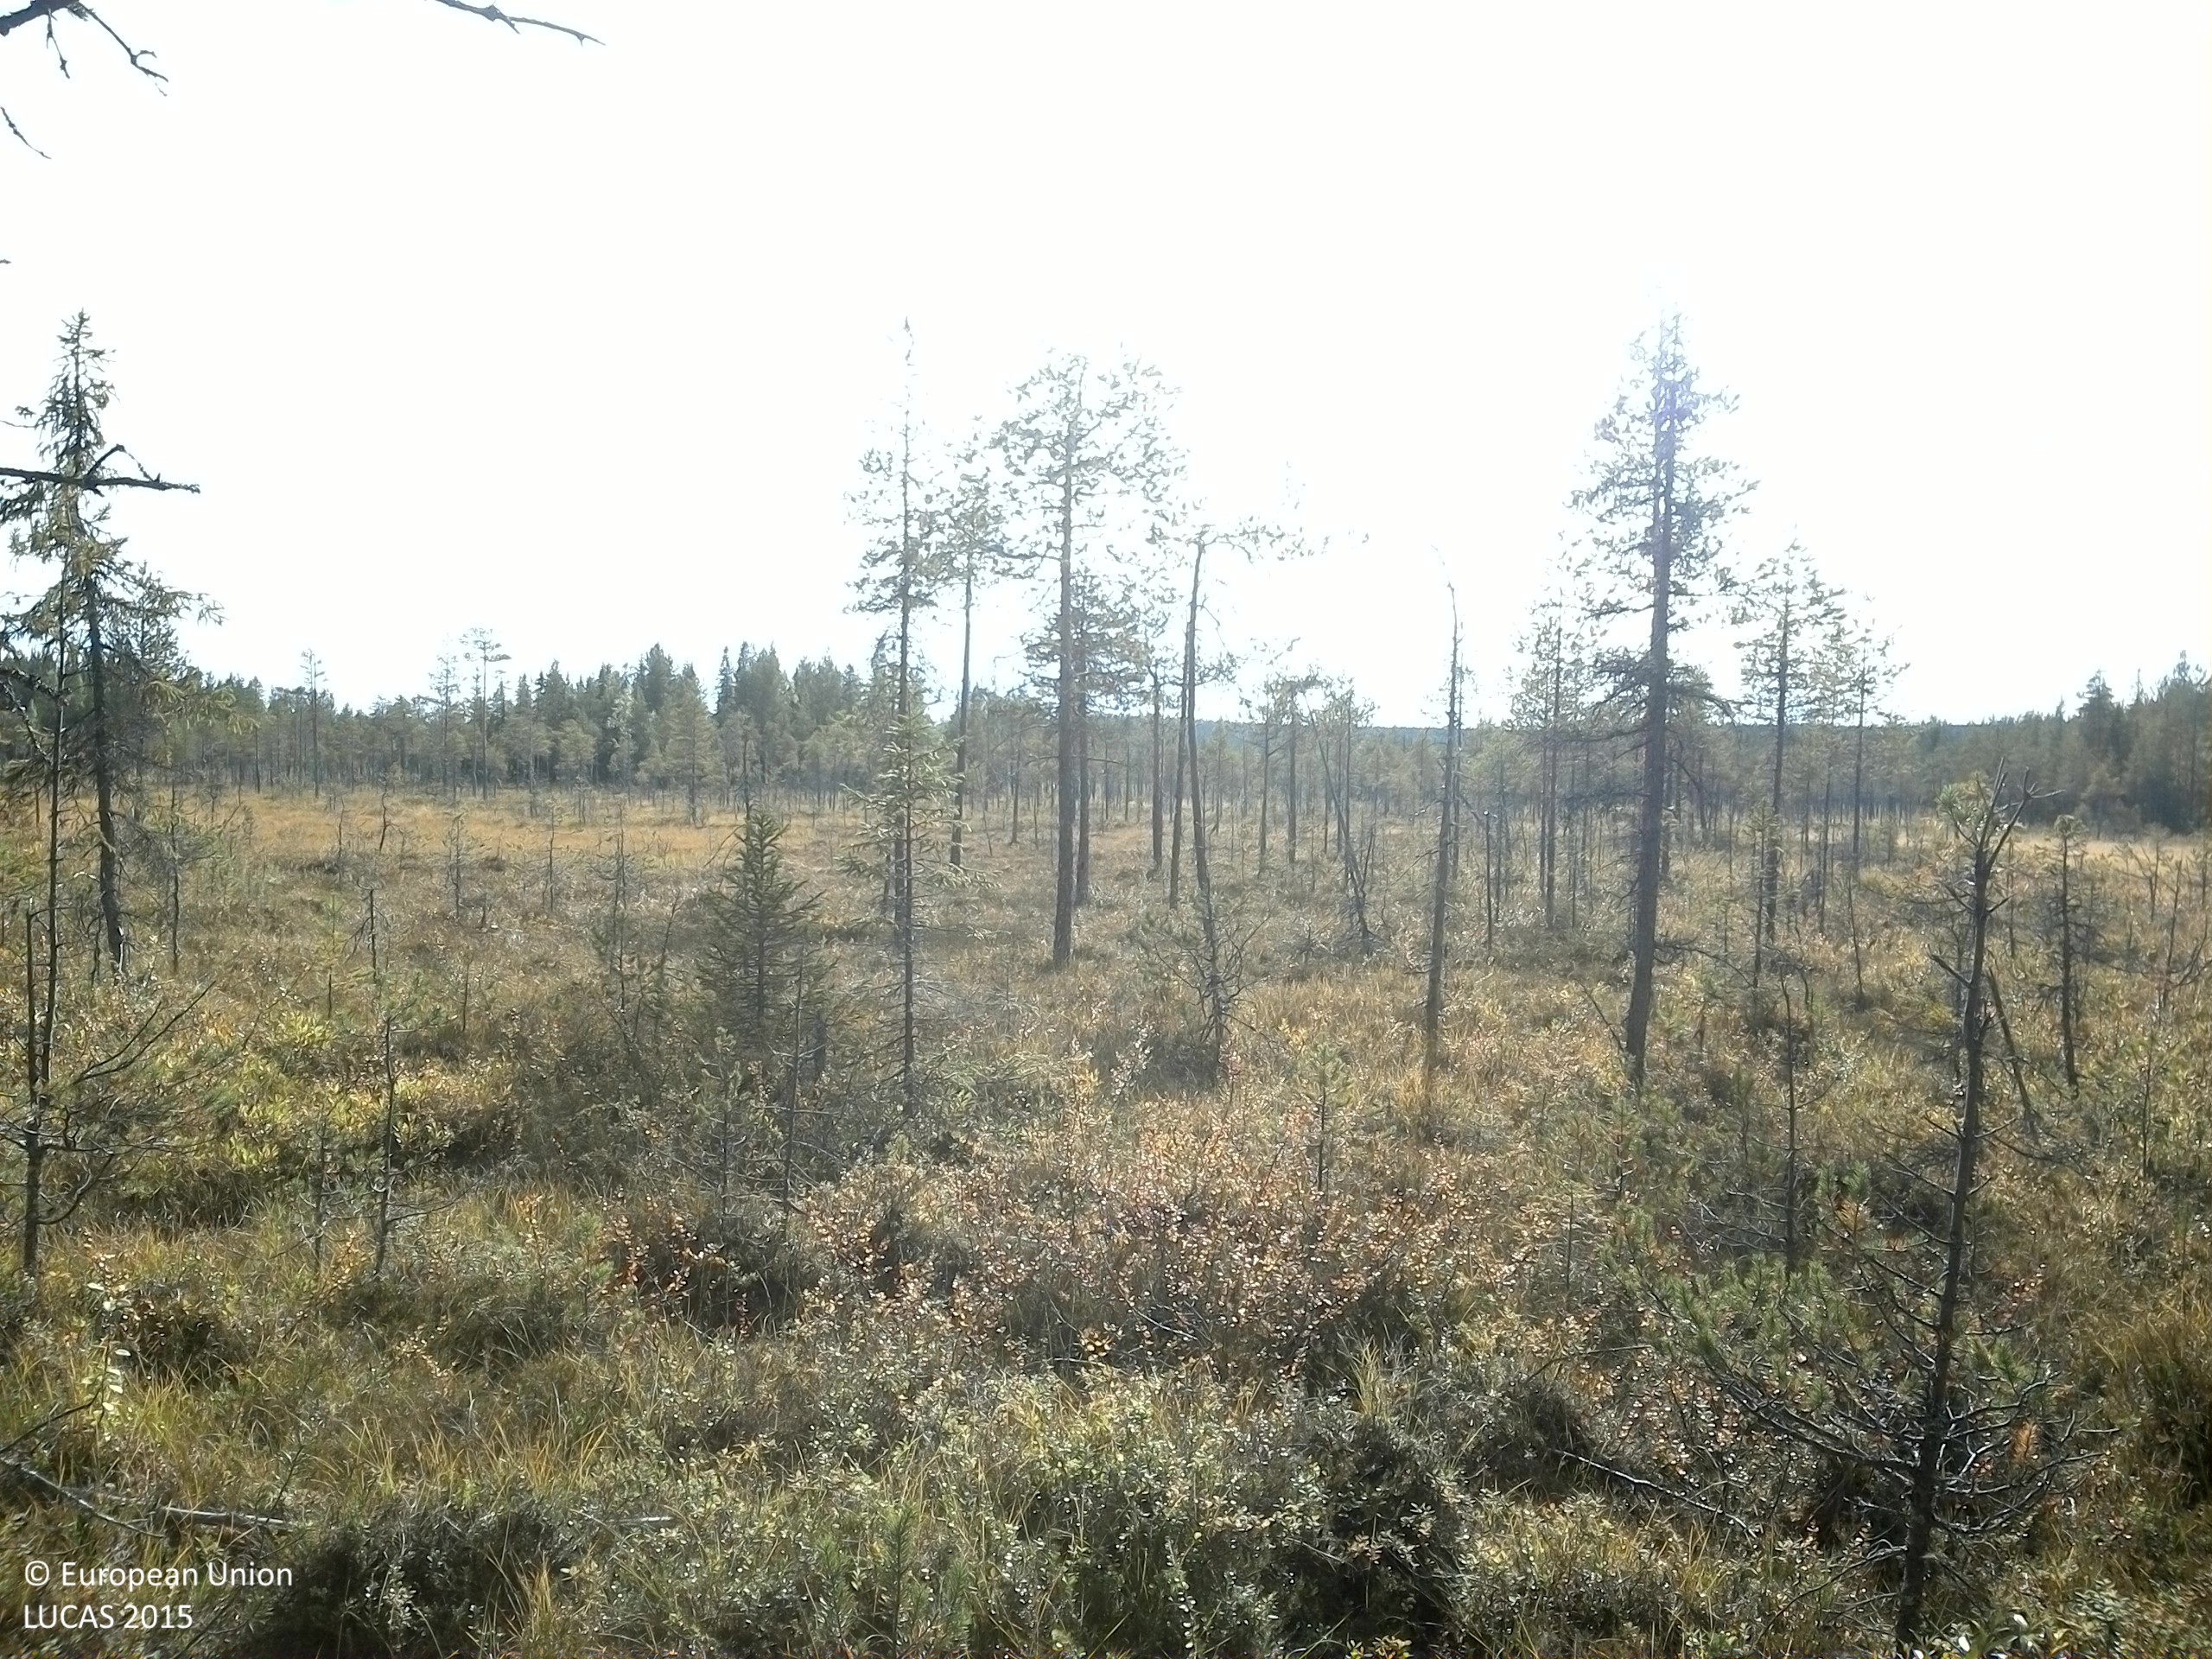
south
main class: Woodland
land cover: Pine dominated coniferous woodland
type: boreal forest
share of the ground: 50 - 75 %
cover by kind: coniferous forest trees 50 %, shrubs 35 %, broadleaved forest trees 10 %, lichens and mosses 5 %
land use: Forestry
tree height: > 5 m
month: September
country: SE
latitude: 64.1853
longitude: 17.4819
